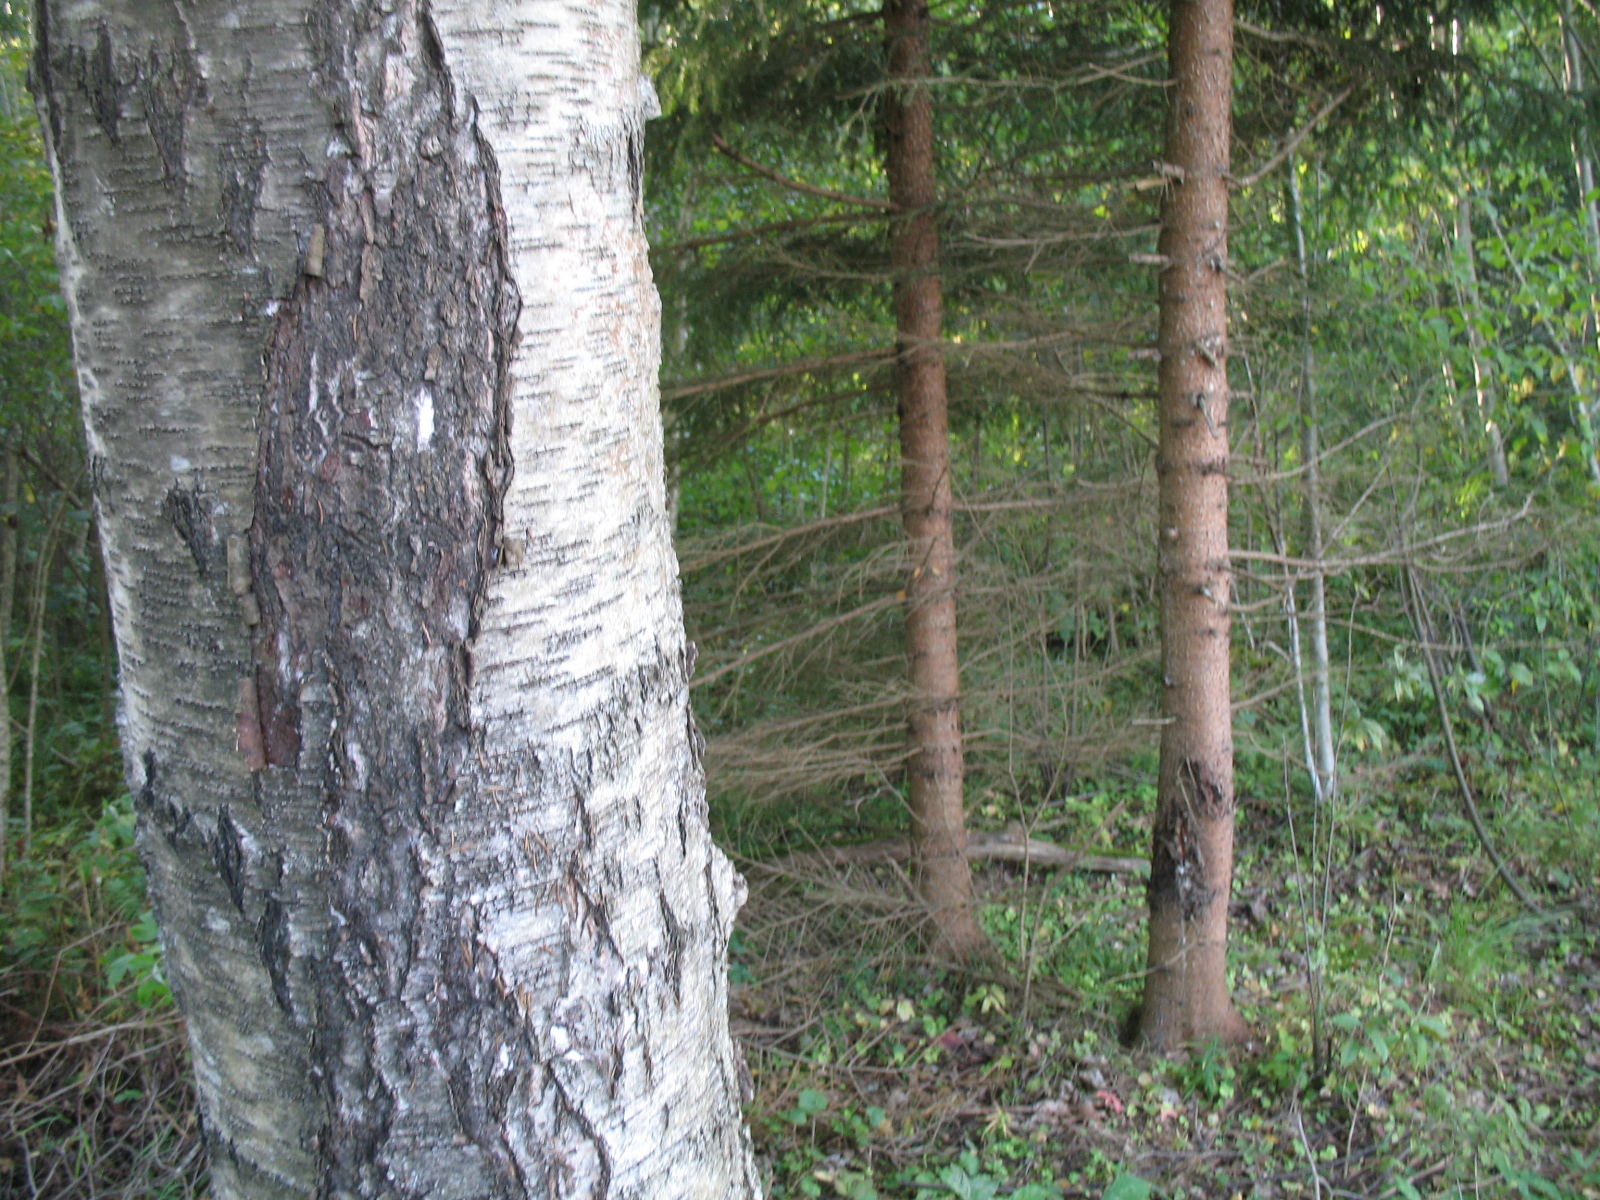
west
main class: Woodland
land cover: Spruce dominated mixed woodland
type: hemiboreal forest and nemoral coniferous forest and mixed broadleaved-coniferous forest
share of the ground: > 75 %
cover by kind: broadleaved forest trees 55 %, coniferous forest trees 25 %, shrubs 10 %, herbaceous plants 10 %
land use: Forestry
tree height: > 5 m
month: September
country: LV
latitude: 56.1396
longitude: 25.9201
